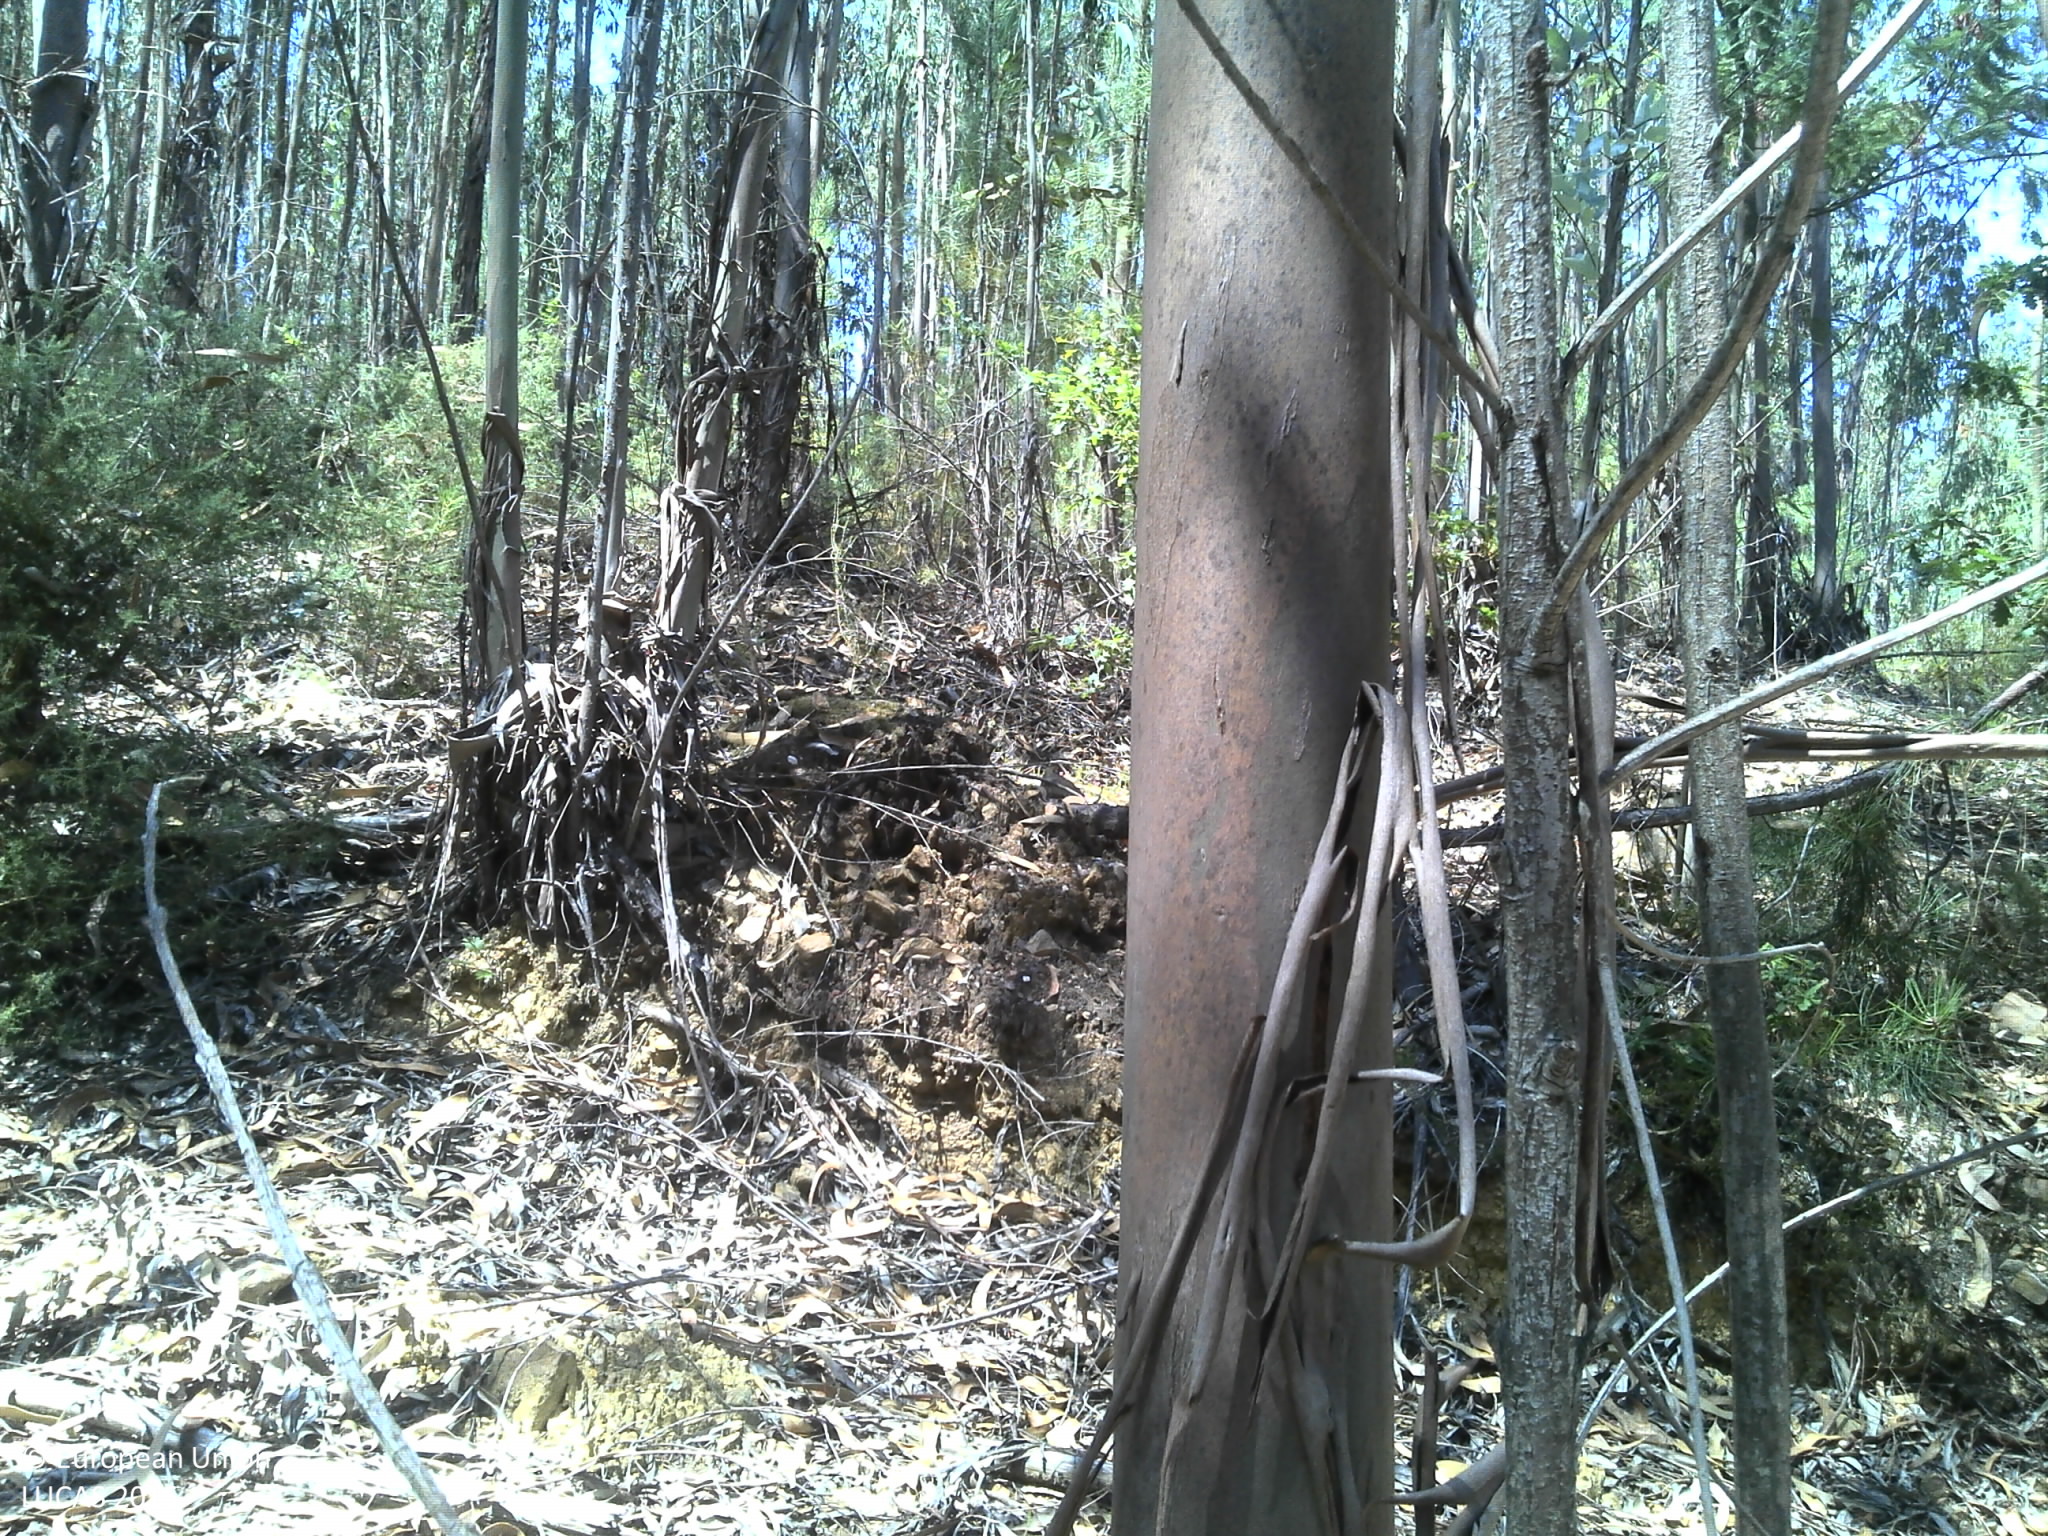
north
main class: Woodland
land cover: Broadleaved woodland
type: exotic forest
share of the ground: 50 - 75 %
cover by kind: broadleaved forest trees 60 %, unconsolidated bare surface 30 %, shrubs 10 %
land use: Forestry
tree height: > 5 m
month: July
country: PT
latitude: 40.3643
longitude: -8.1792
